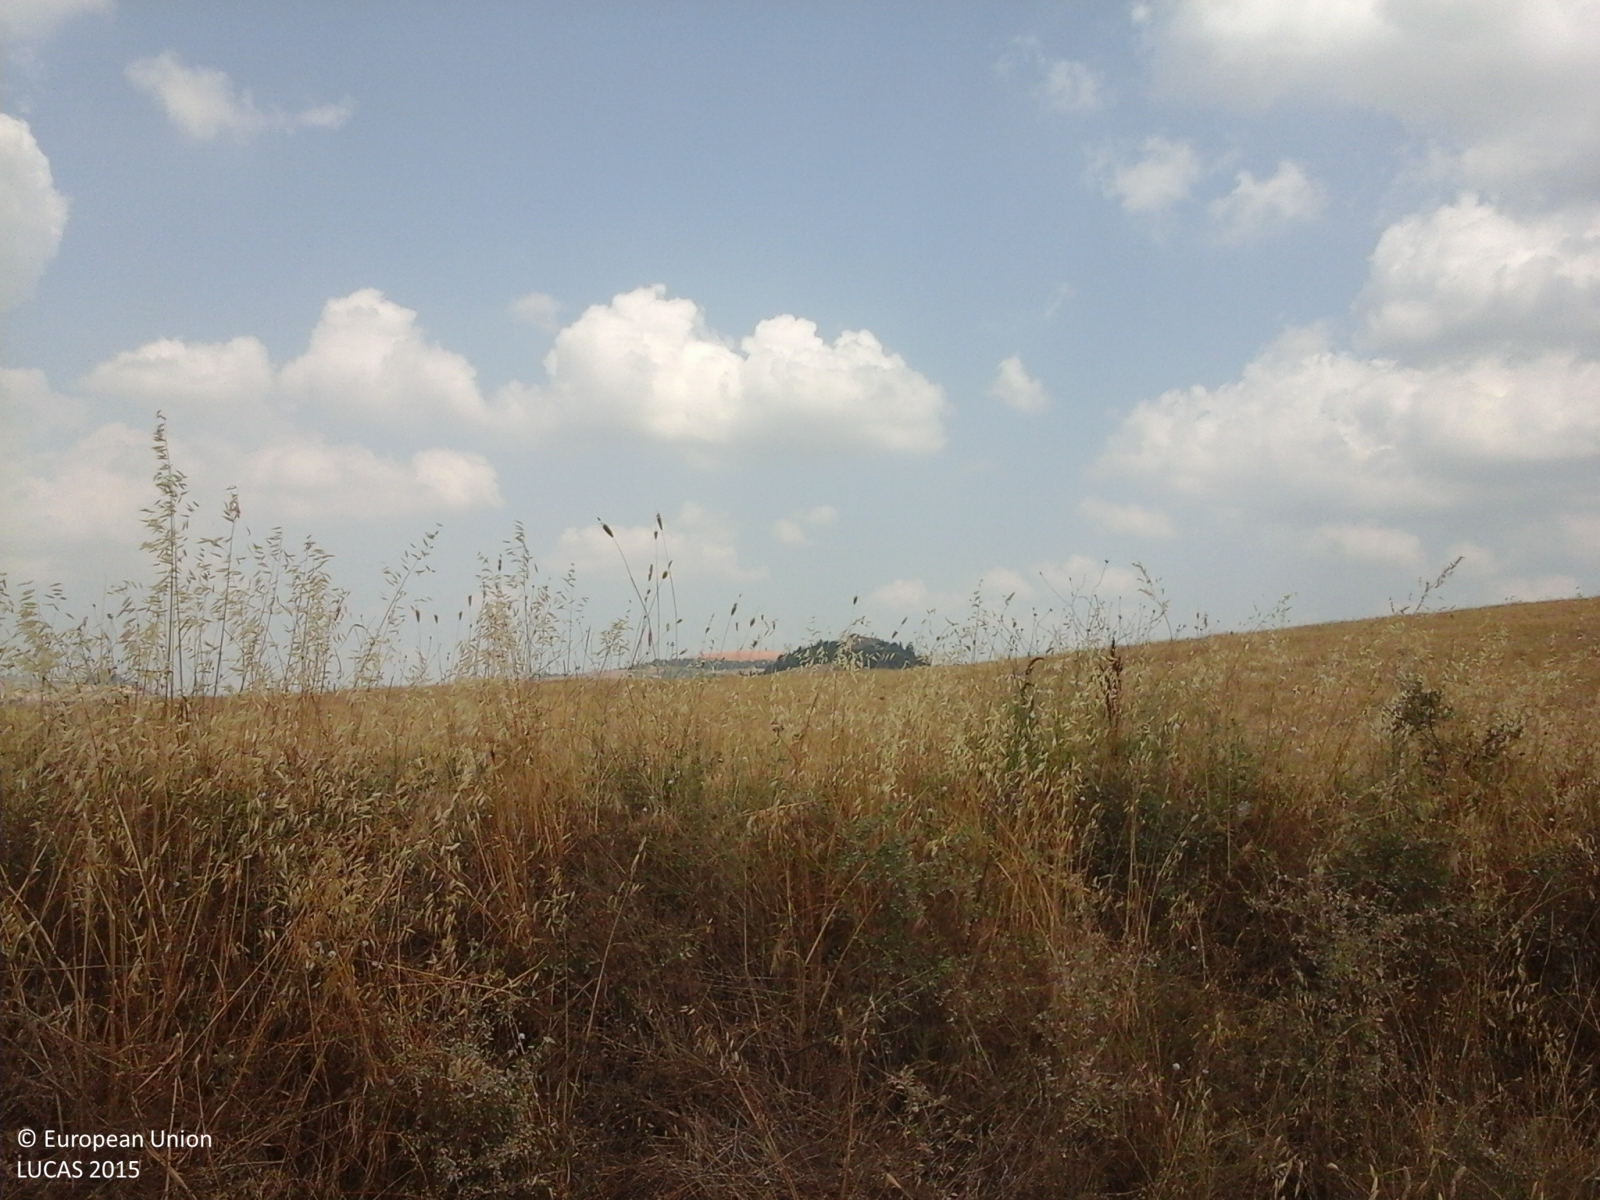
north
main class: Cropland
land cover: Temporary grasslands
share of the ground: > 75 %
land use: Agriculture (excluding fallow land and kitchen gardens)
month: July
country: IT
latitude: 43.3542
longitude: 10.8981
